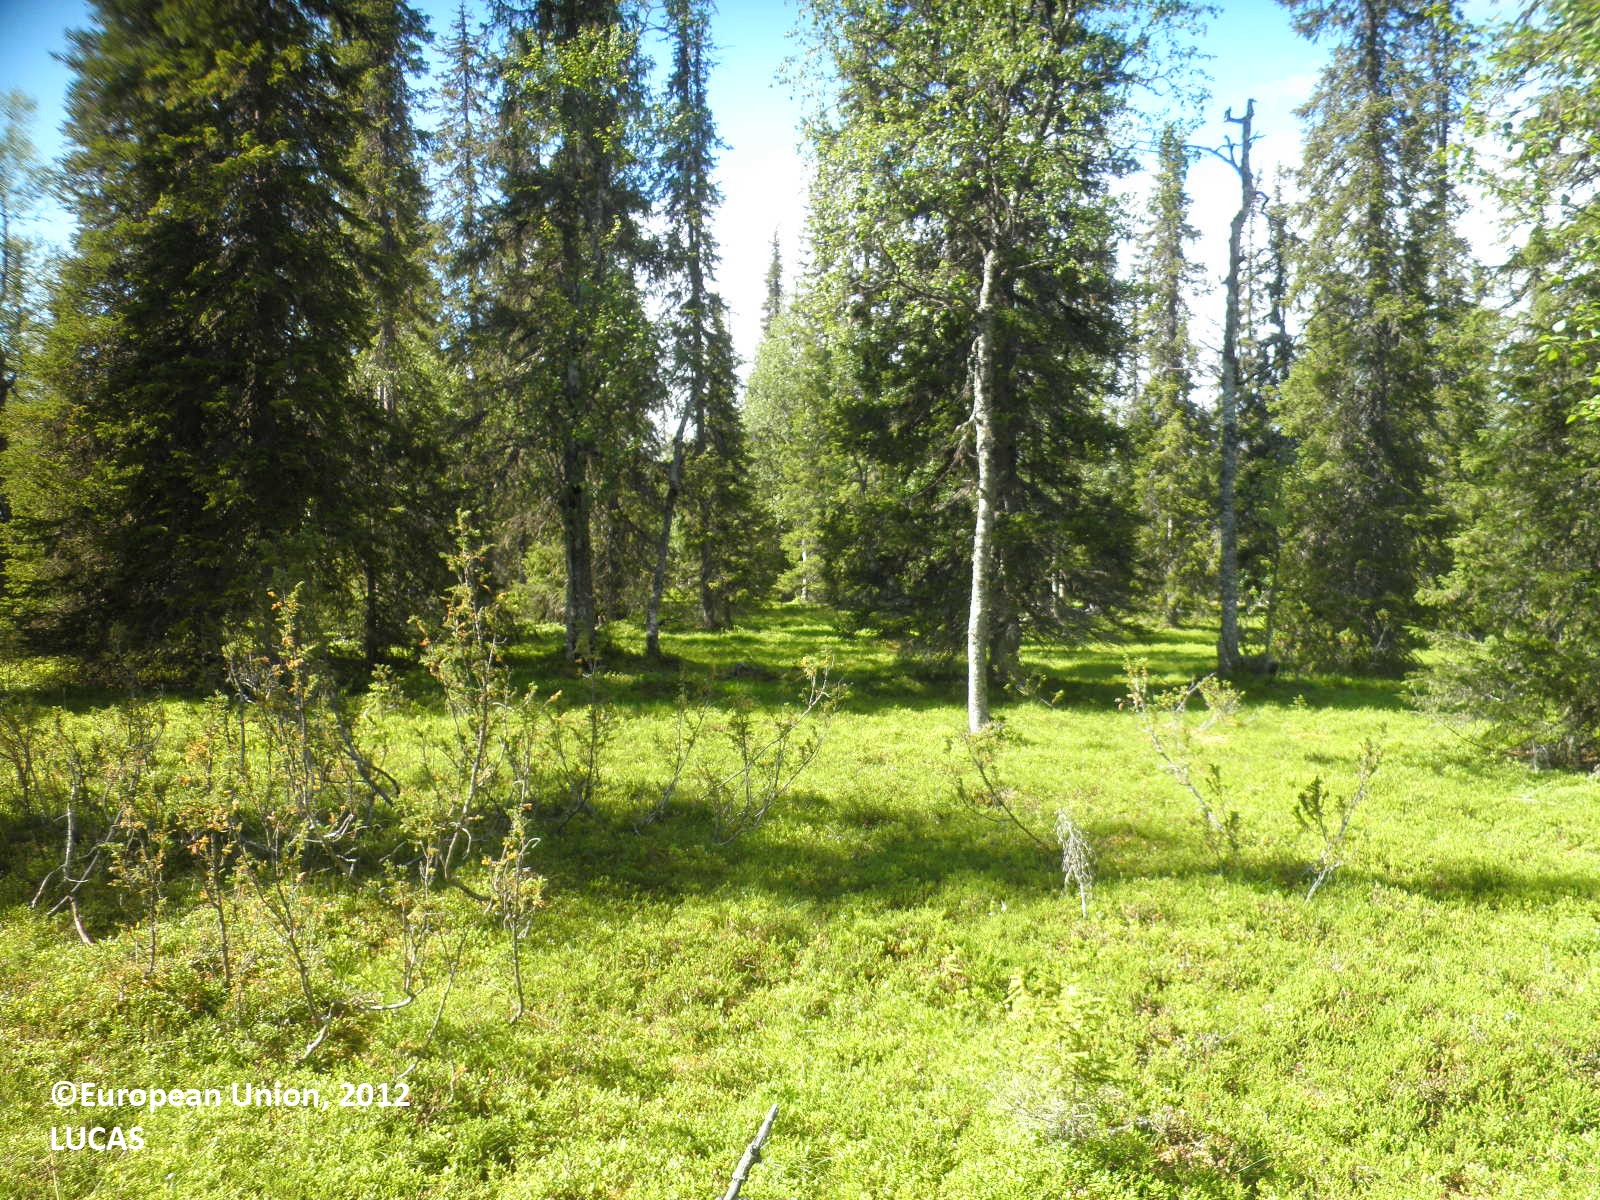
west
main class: Woodland
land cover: Spruce dominated mixed woodland
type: boreal forest
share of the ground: 50 - 75 %
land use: Forestry
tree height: > 5 m
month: July
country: FI
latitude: 67.9263
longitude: 26.1516
